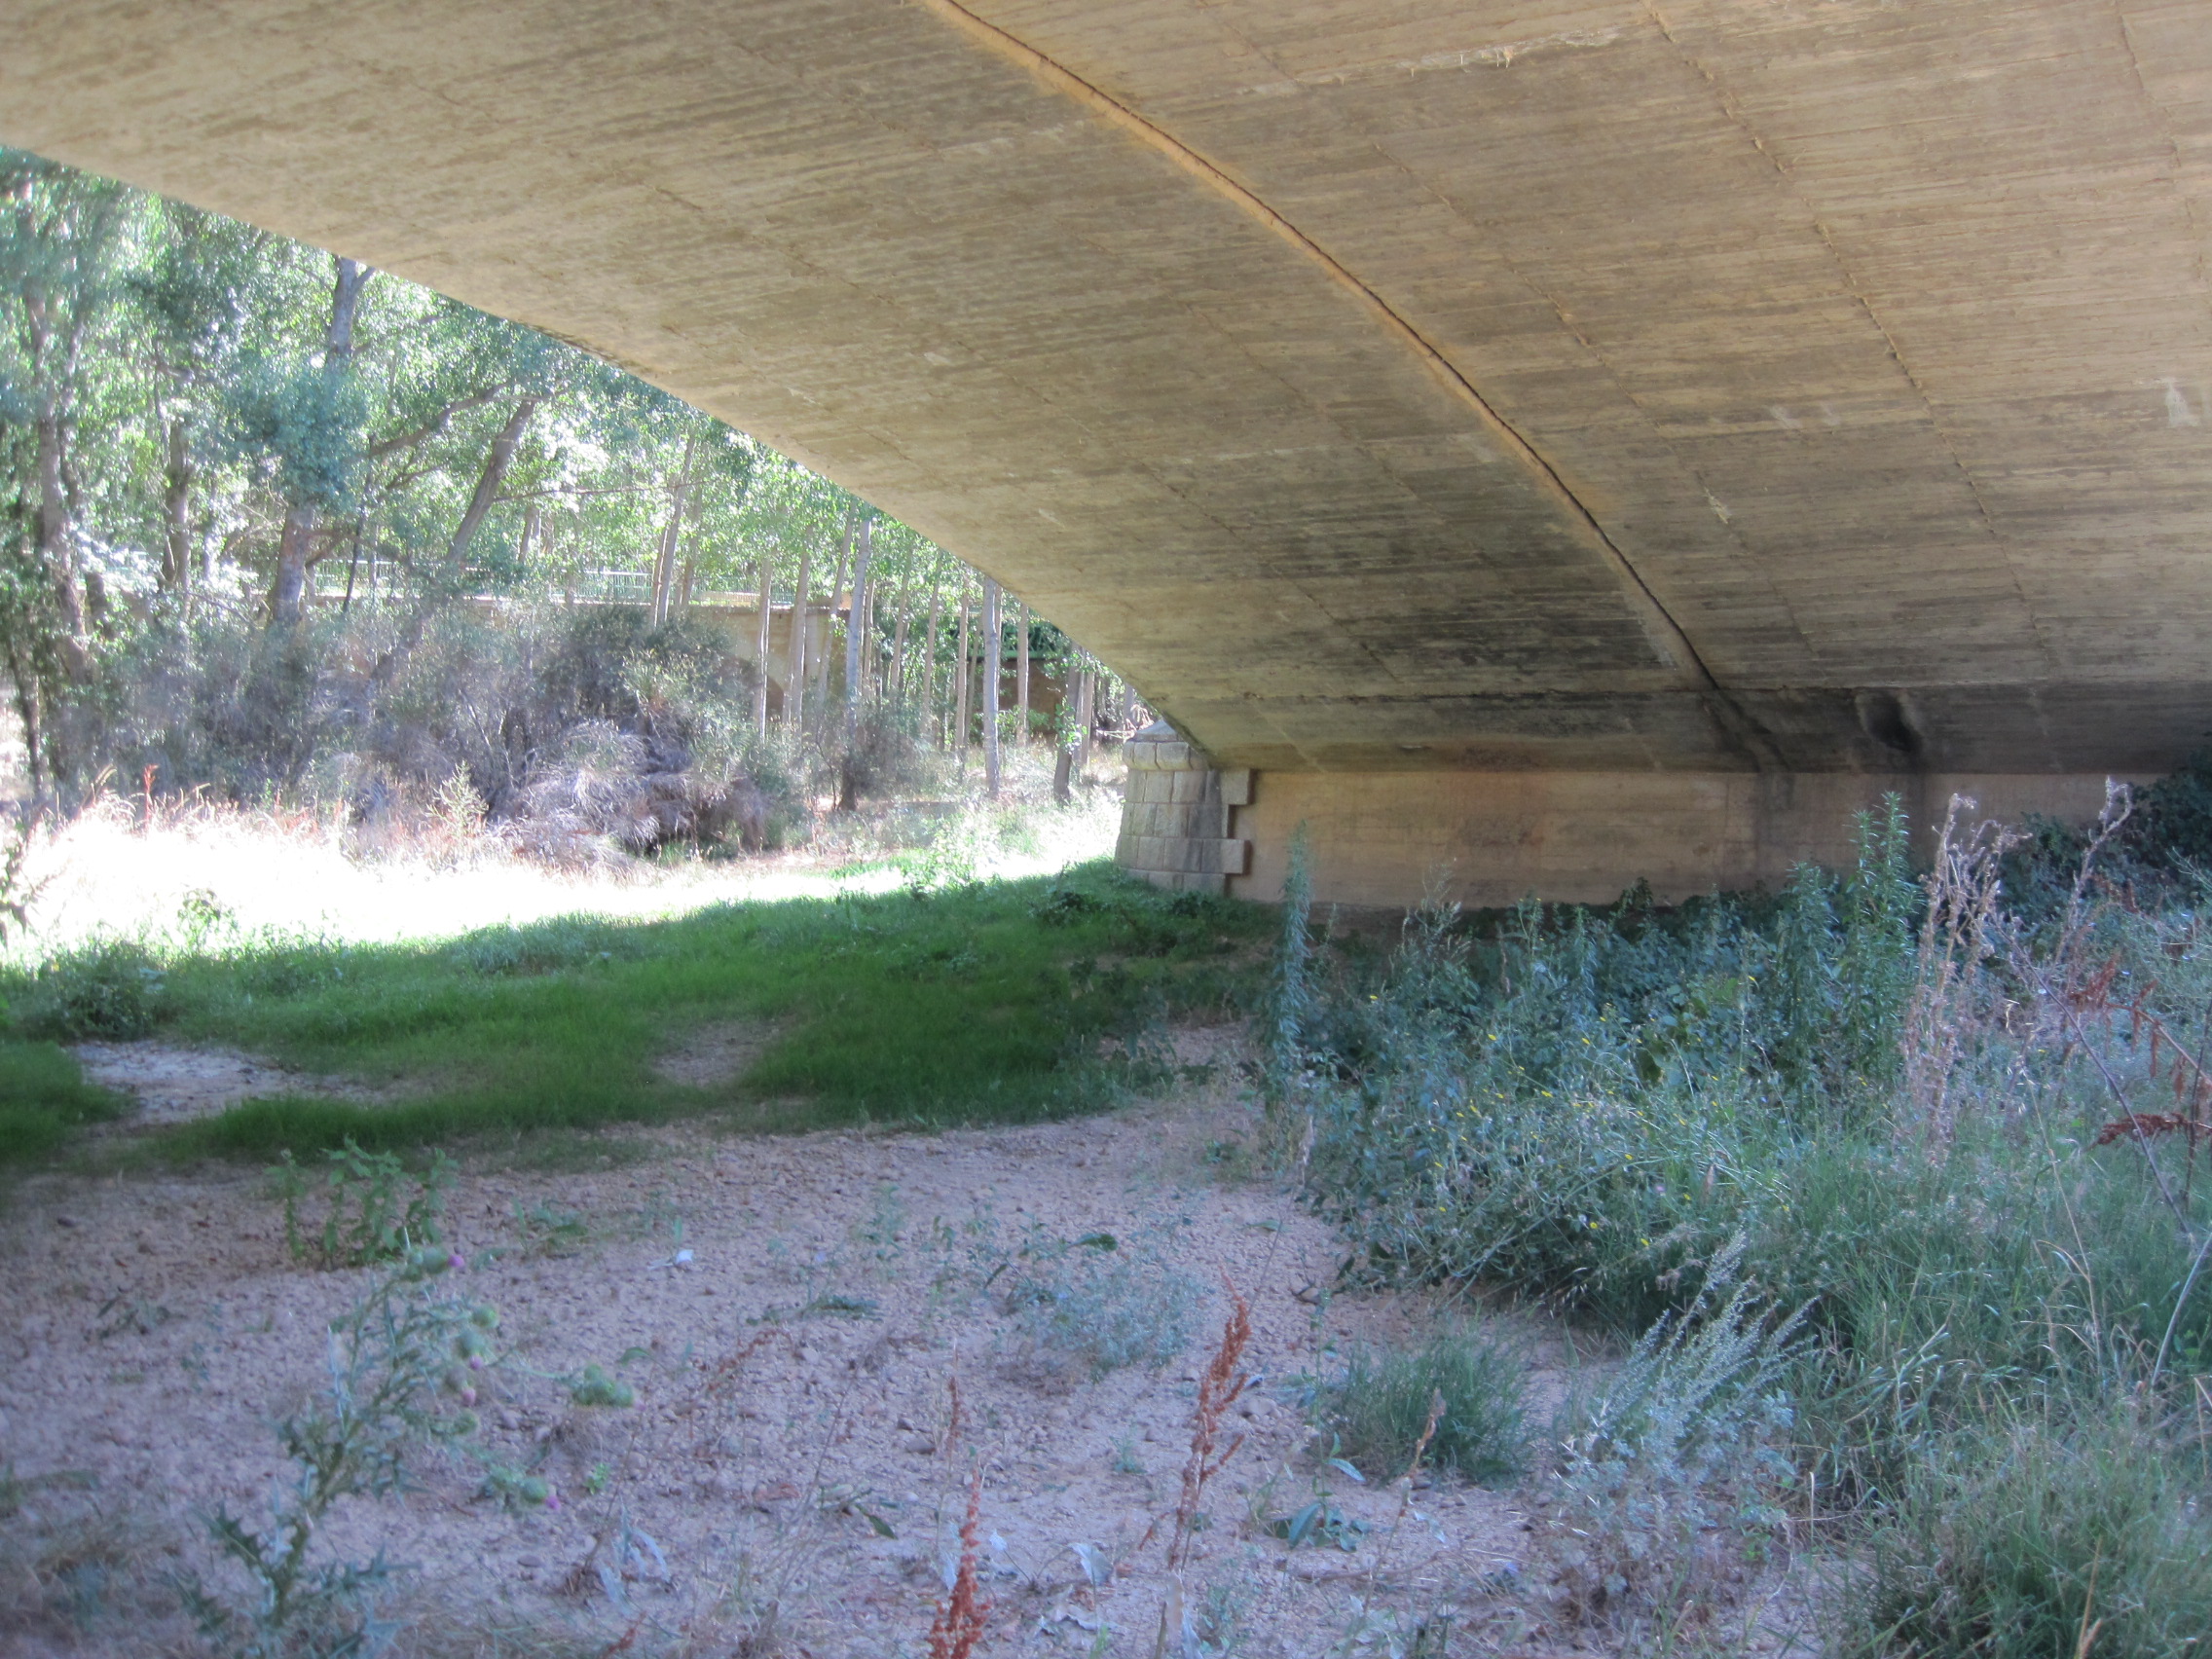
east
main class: Artificial land
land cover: Non built-up linear features
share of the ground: > 75 %
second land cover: Grassland without tree/shrub cover
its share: > 75 %
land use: Road transport
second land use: Forestry
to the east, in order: Paved roads, cycling and walking lanes; Grassland without tree/shrub cover; Broadleaved woodland; Tracks; Artificial constructions; Paved roads, cycling and walking lanes; Broadleaved woodland; Grassland without tree/shrub cover; Apple fruit; Other bare soil; Artificial constructions in urban areas
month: July
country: ES
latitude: 41.9837
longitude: -5.6241
